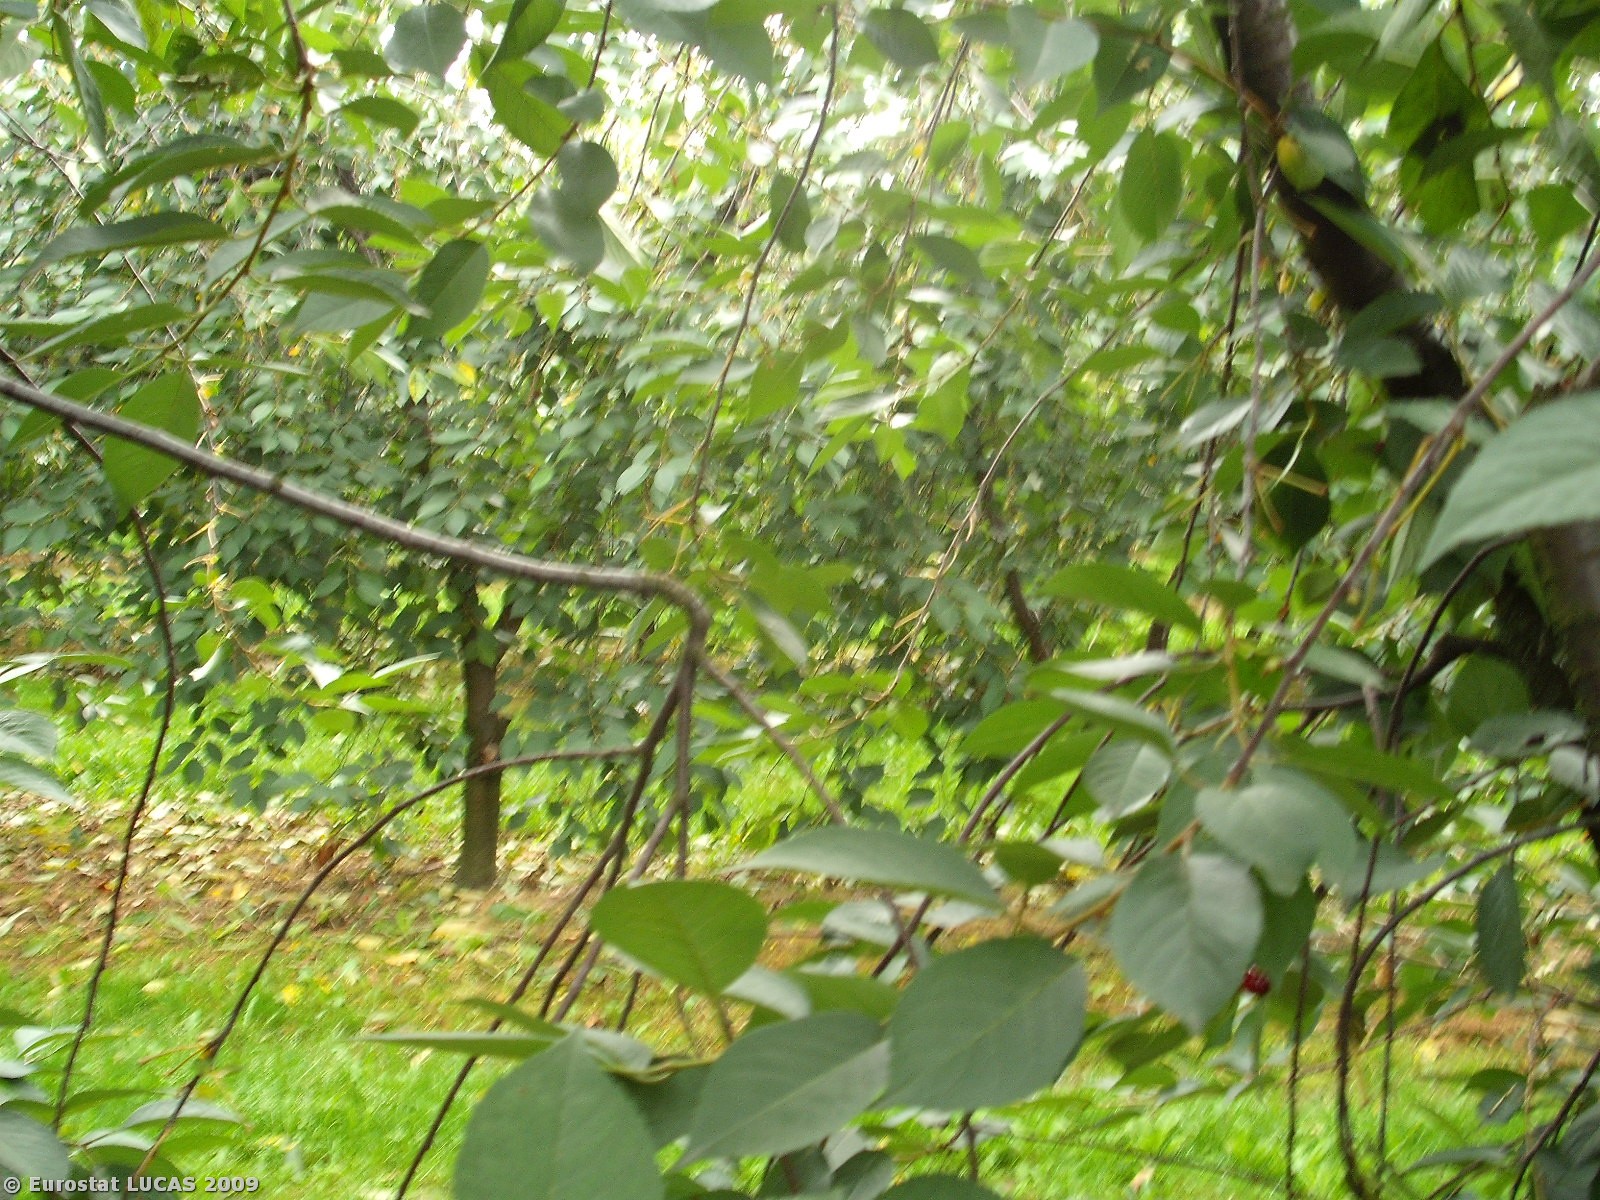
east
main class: Cropland
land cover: Cherry fruit
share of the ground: 50 - 75 %
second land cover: Grassland with sparse tree/shrub cover
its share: > 75 %
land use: Agriculture (excluding fallow land and kitchen gardens)
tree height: < 5 m
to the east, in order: Cherry fruit; Grassland with sparse tree/shrub cover; Fences; Cherry fruit; Apple fruit; Tracks; Grassland without tree/shrub cover; Cherry fruit; Tracks; Apple fruit; Cherry fruit
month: August
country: PL
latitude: 51.7970
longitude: 21.1389
